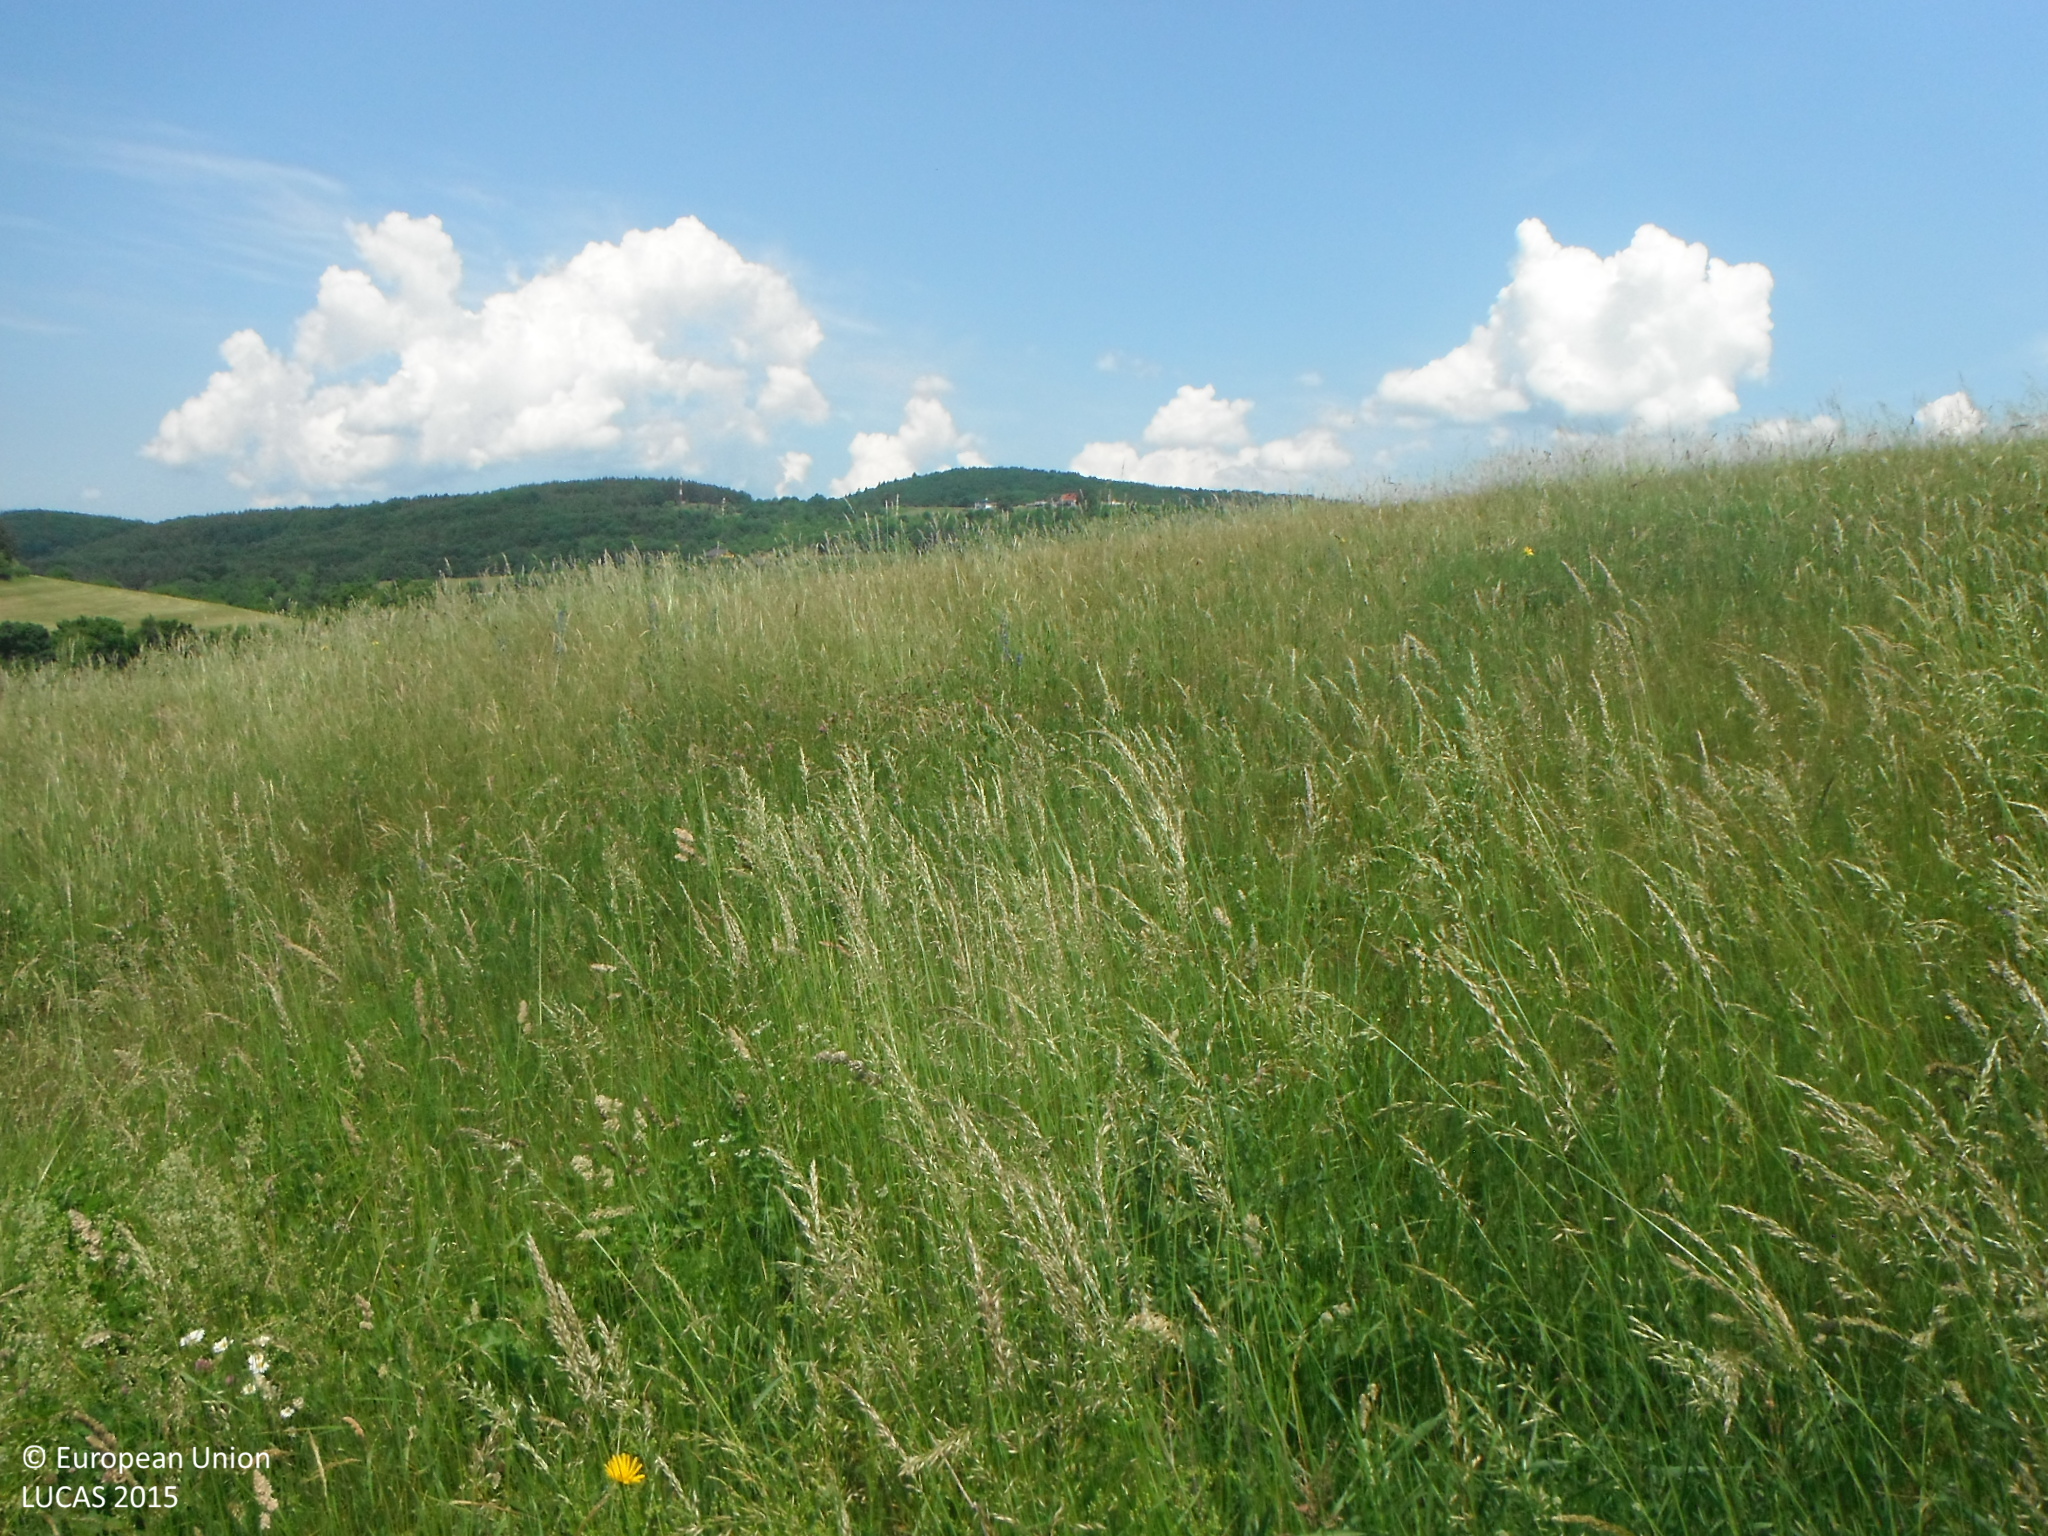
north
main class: Grassland
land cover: Grassland without tree/shrub cover
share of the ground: > 75 %
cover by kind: herbaceous plants 100 %
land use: Agriculture (excluding fallow land and kitchen gardens)
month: June
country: SK
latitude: 48.7077
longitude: 19.1955
